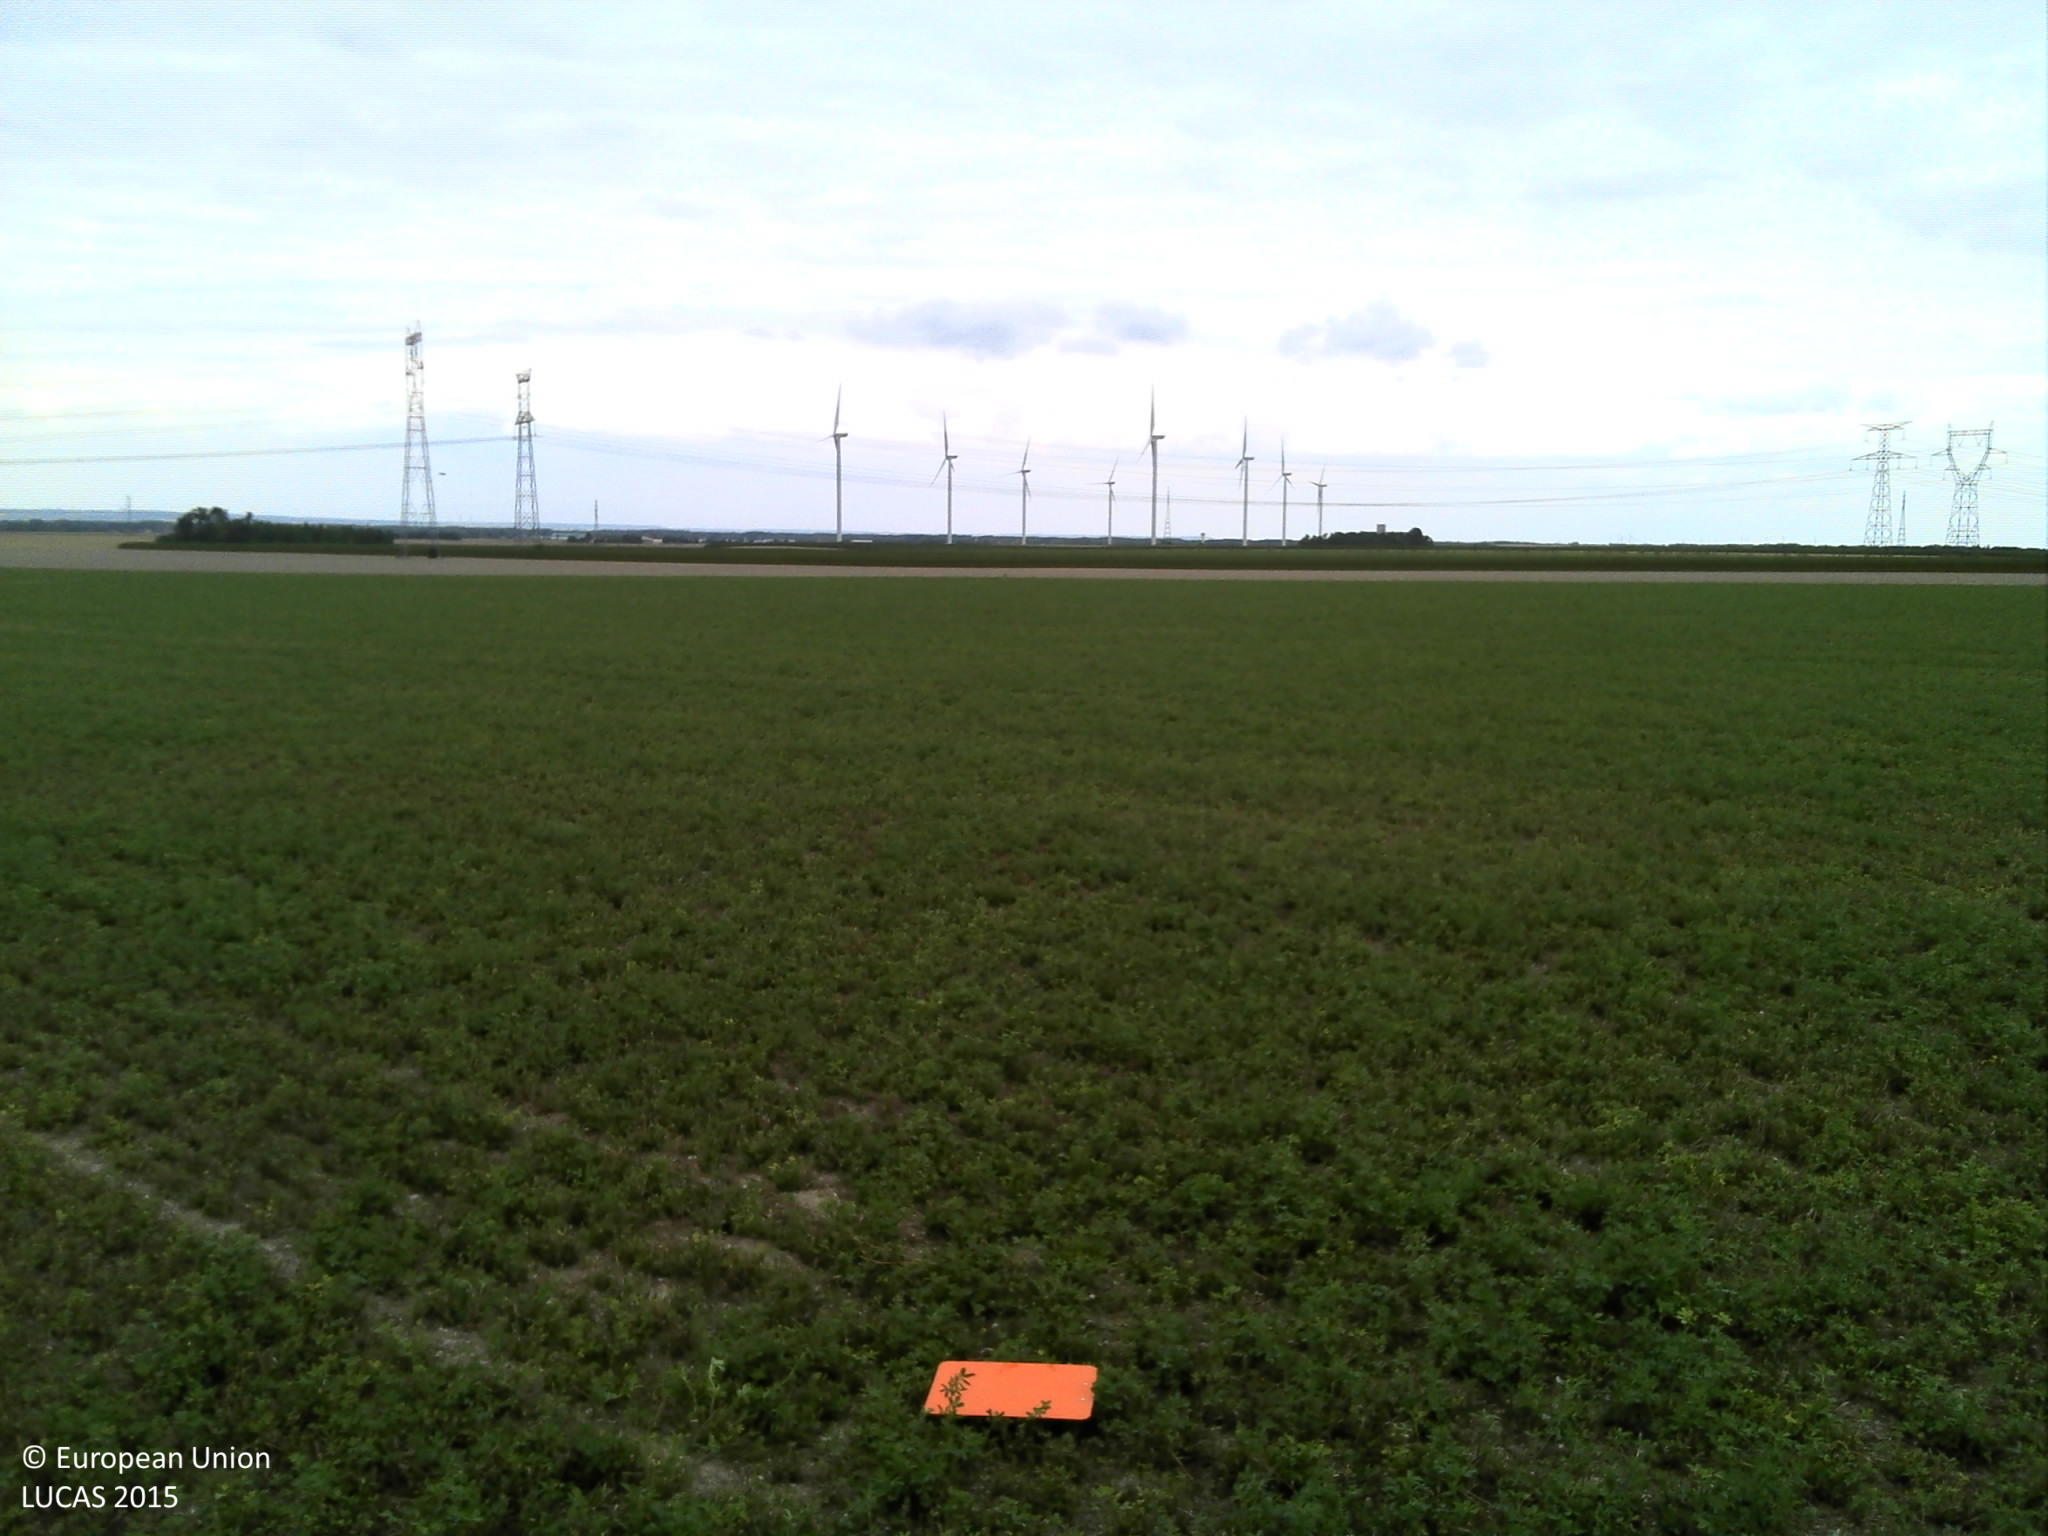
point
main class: Cropland
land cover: Lucerne
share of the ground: 50 - 75 %
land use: Agriculture (excluding fallow land and kitchen gardens)
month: August
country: FR
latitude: 48.4649
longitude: 3.8146
